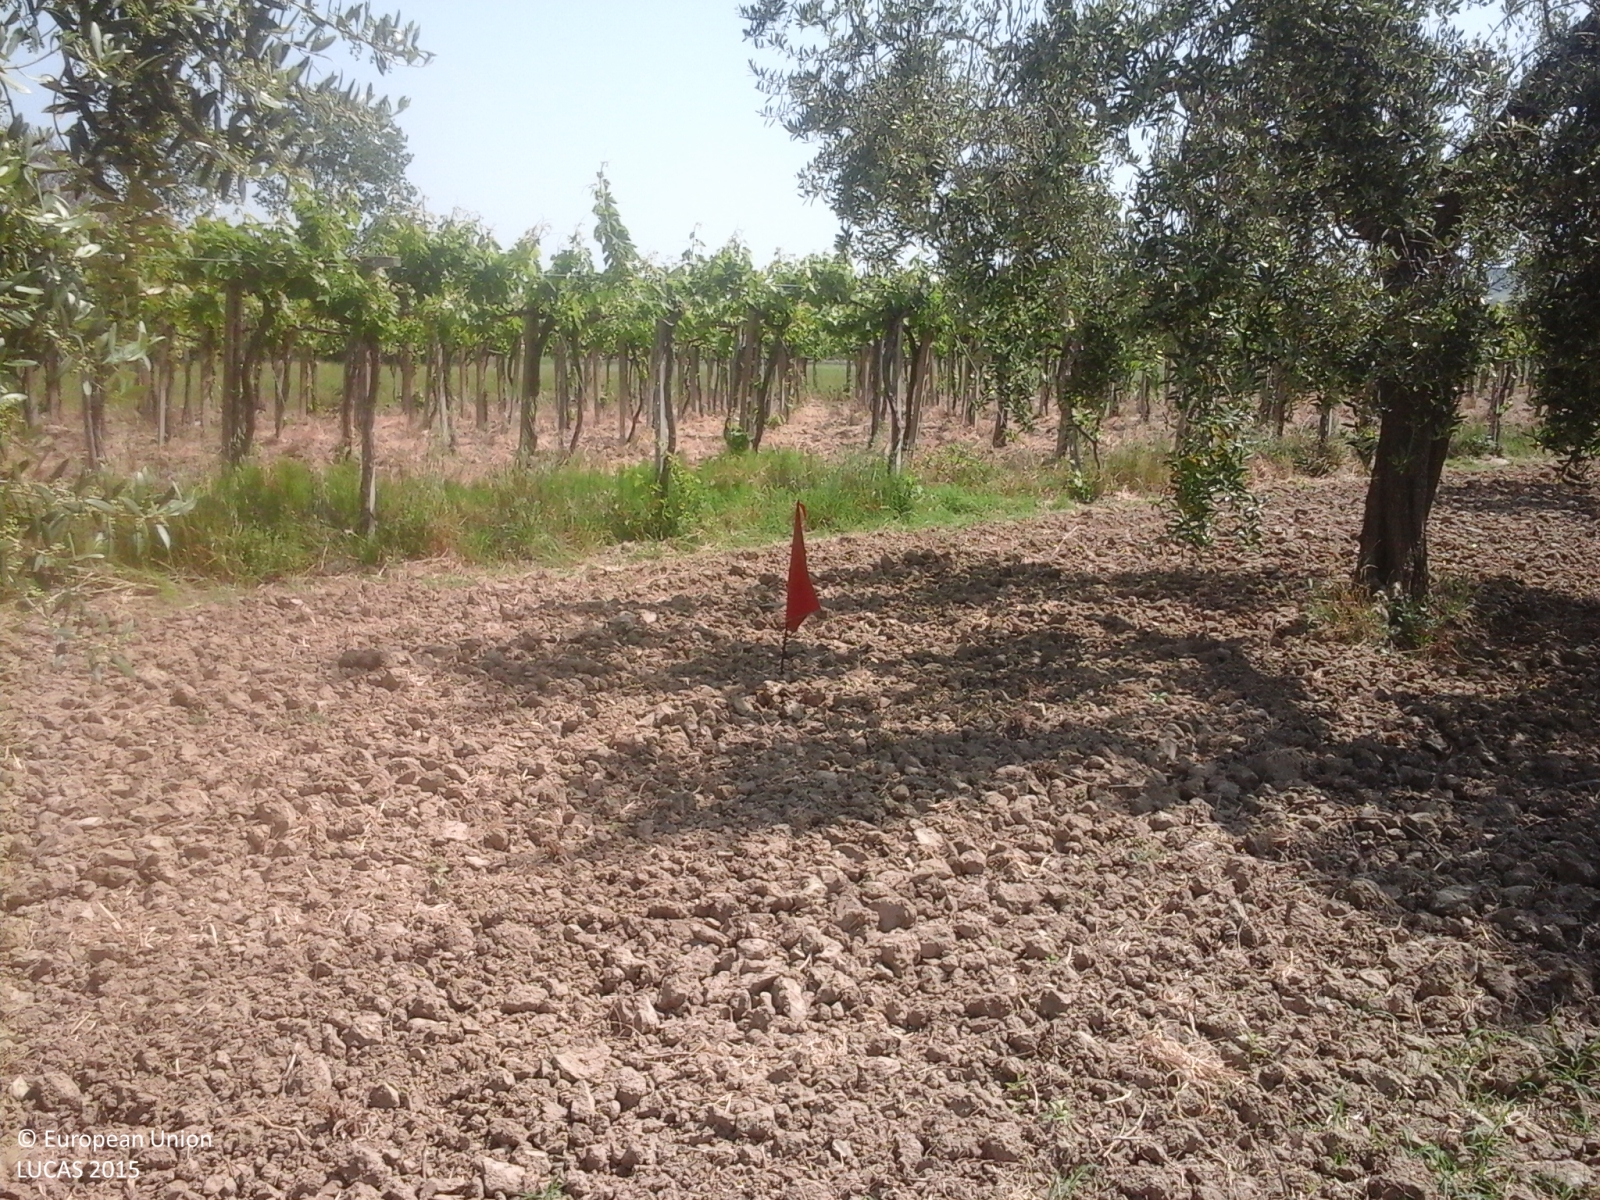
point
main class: Cropland
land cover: Olive groves
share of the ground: 25 - 50 %
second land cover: Other bare soil
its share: > 75 %
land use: Agriculture (excluding fallow land and kitchen gardens)
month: May
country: IT
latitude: 42.2101
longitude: 14.5044
